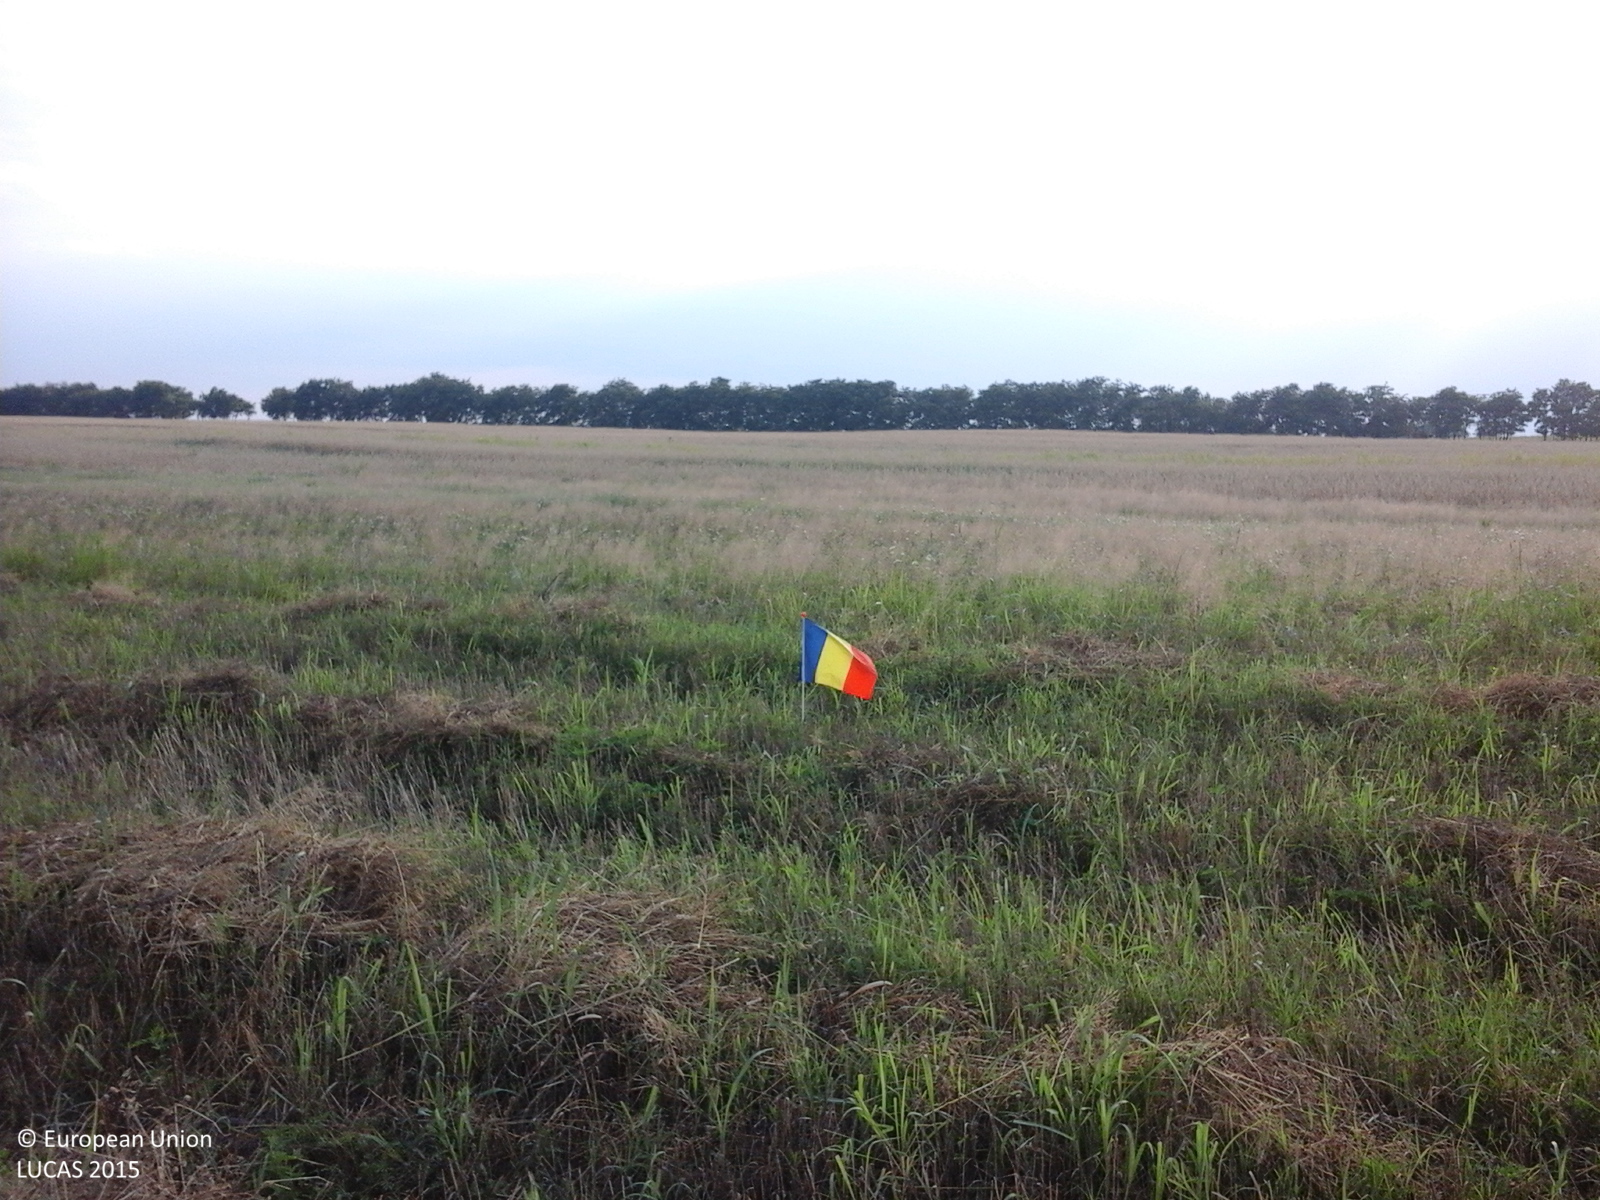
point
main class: Cropland
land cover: Common wheat
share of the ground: < 10 %
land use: Agriculture (excluding fallow land and kitchen gardens)
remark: Harvested field
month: July
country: RO
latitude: 43.7965
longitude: 24.0130
